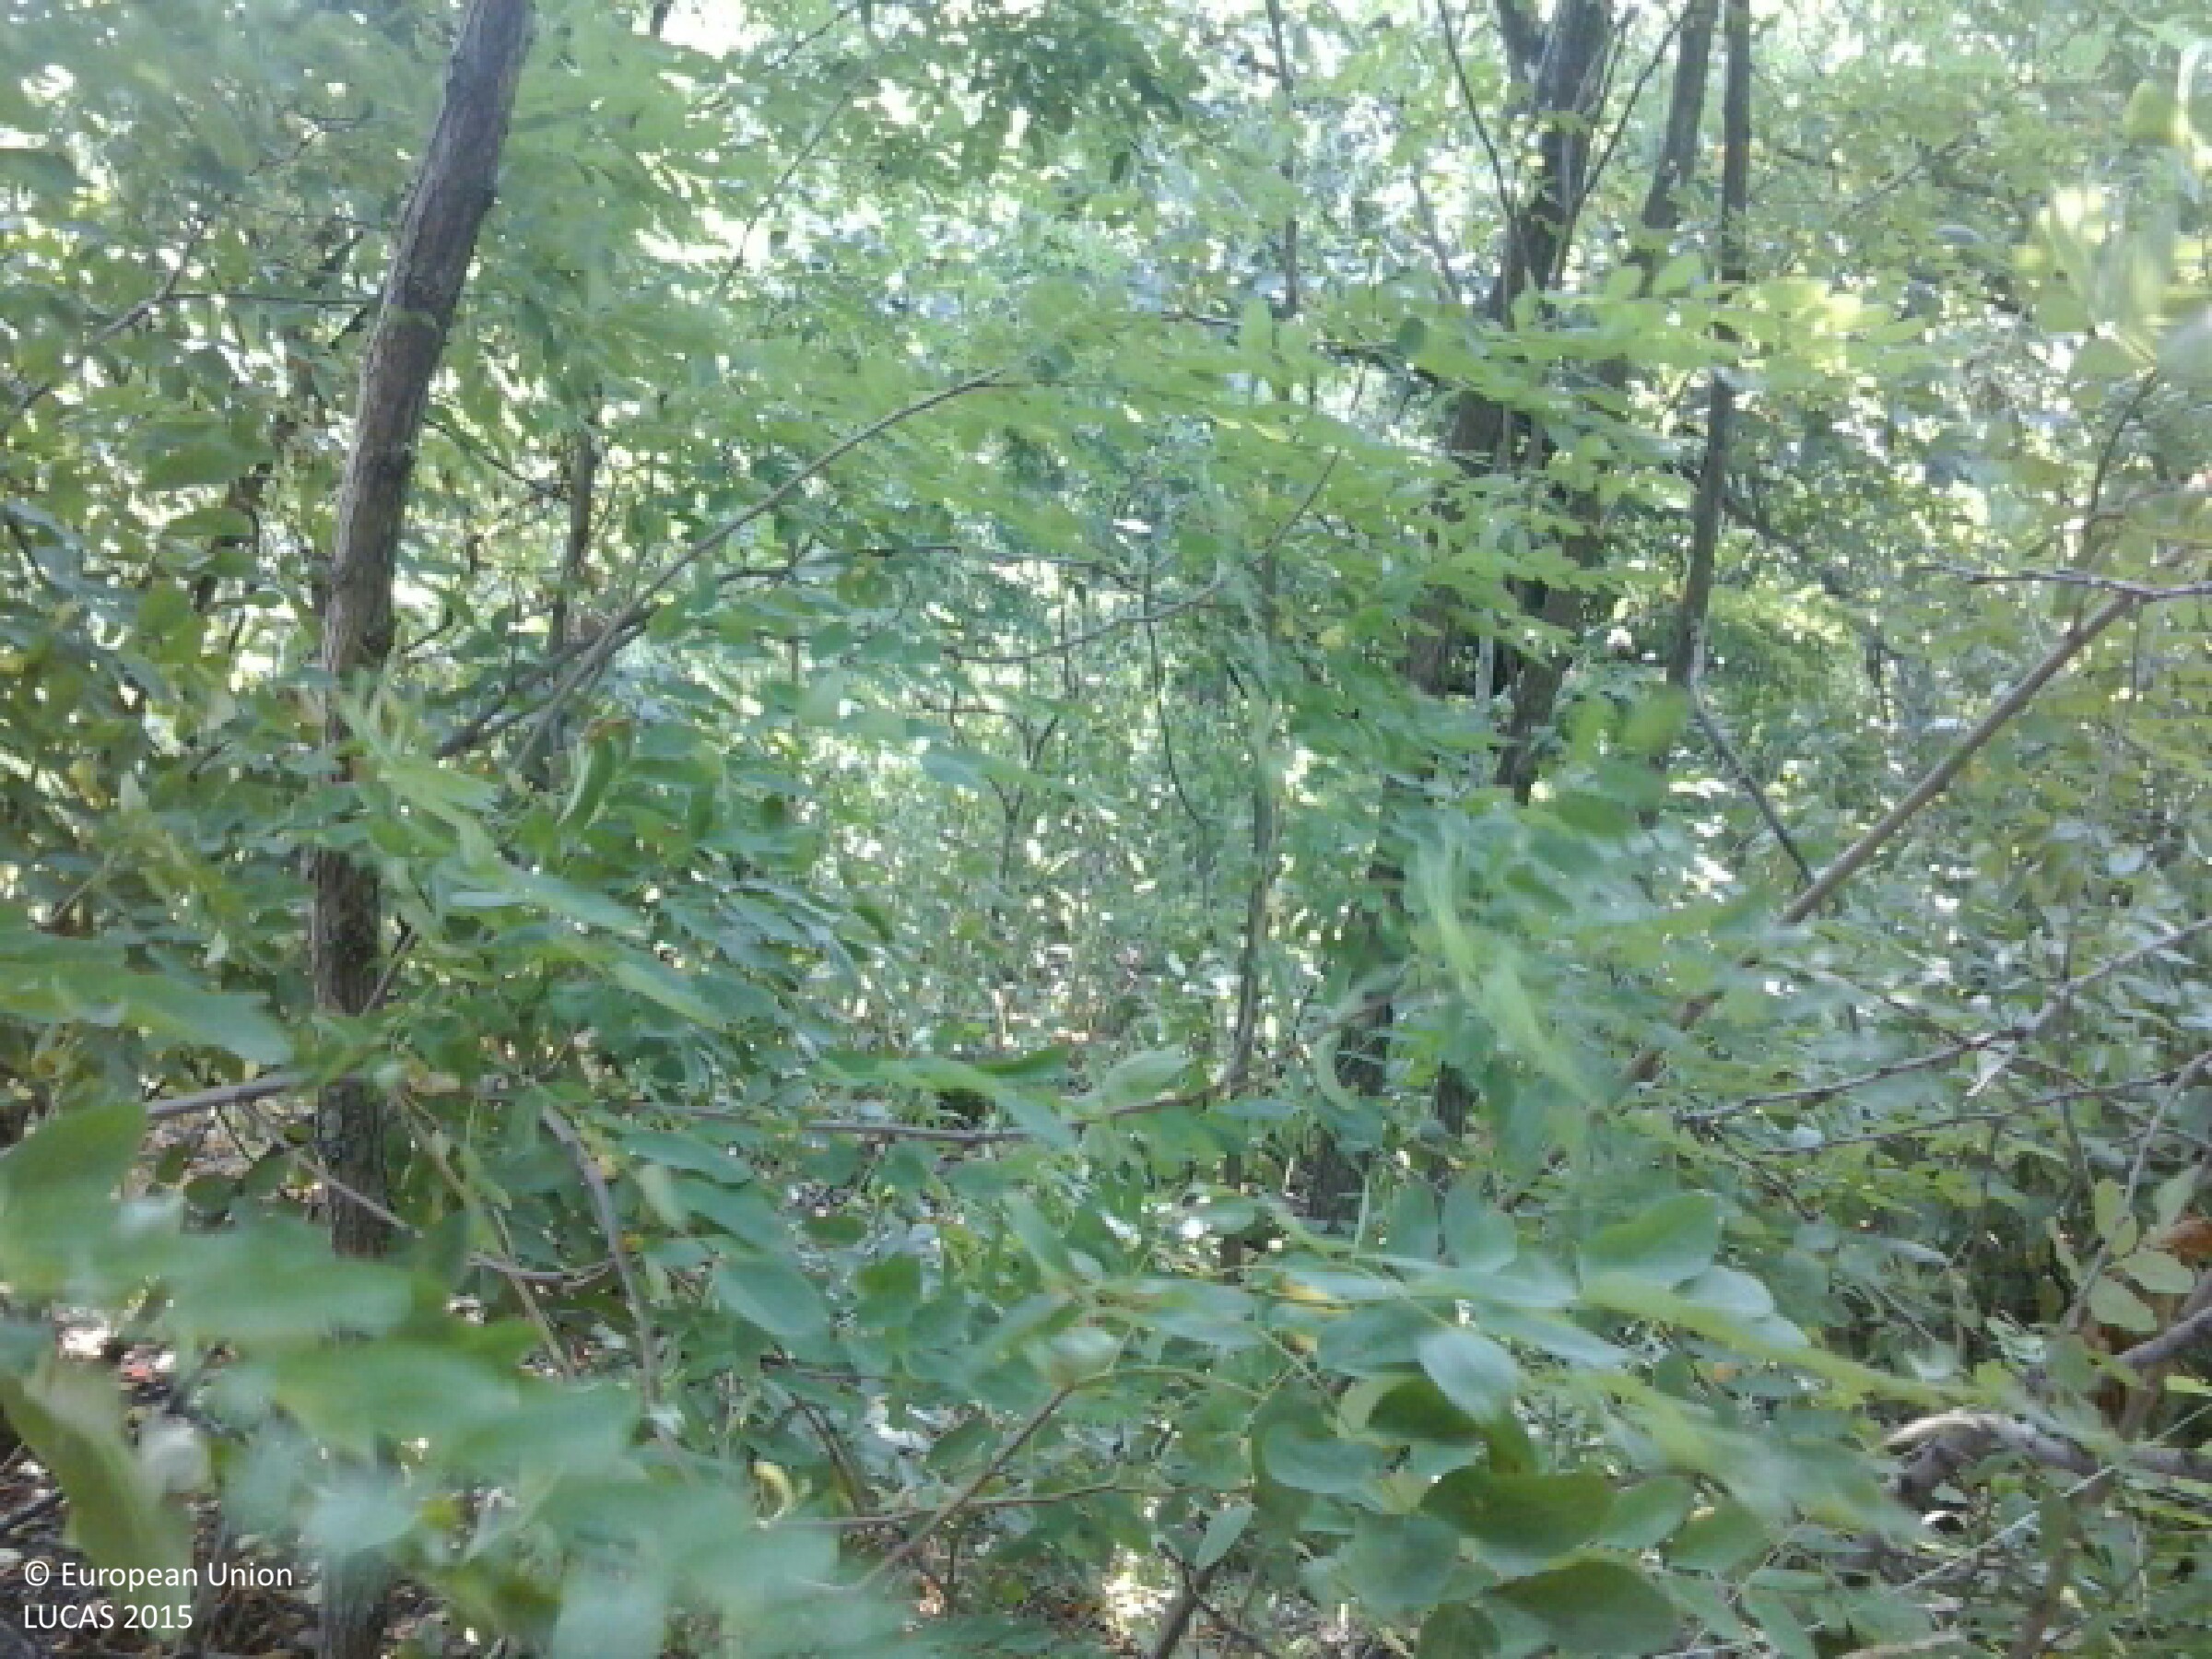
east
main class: Woodland
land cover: Broadleaved woodland
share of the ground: > 75 %
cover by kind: broadleaved forest trees 95 %, shrubs 5 %
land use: Forestry
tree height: < 5 m
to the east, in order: Broadleaved woodland; Triticale
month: July
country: HU
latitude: 48.2098
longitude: 21.0618
